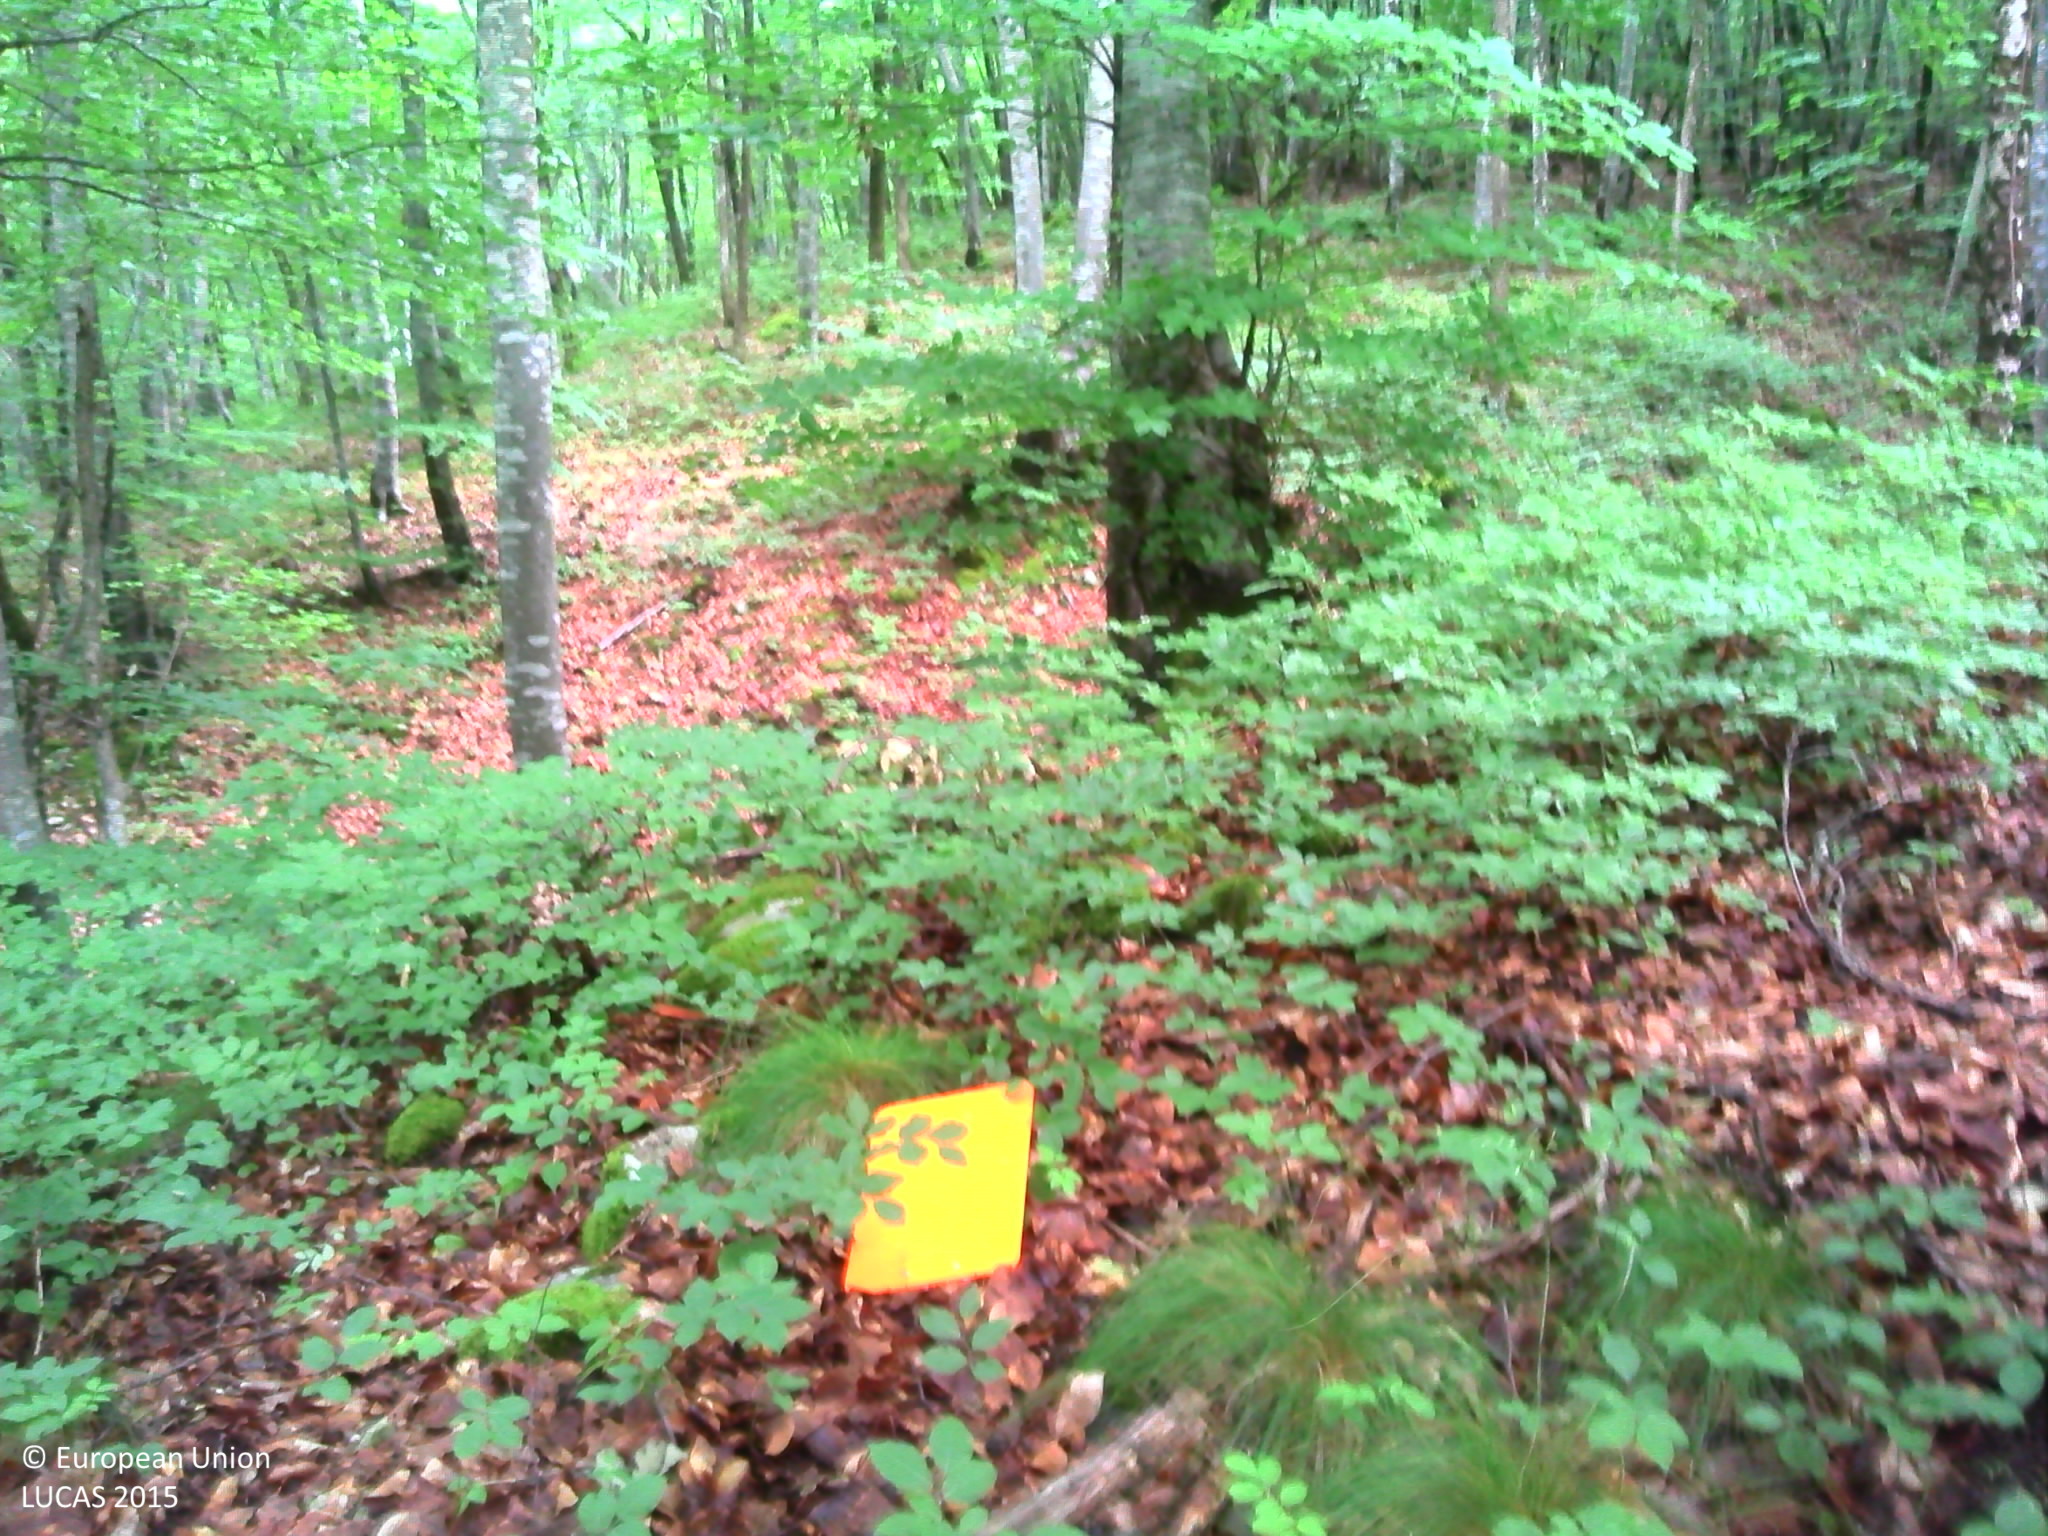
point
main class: Woodland
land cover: Broadleaved woodland
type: beech forest
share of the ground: > 75 %
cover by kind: broadleaved forest trees 95 %, lichens and mosses 5 %
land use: Forestry
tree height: > 5 m
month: June
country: FR
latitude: 44.6696
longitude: 5.1251
